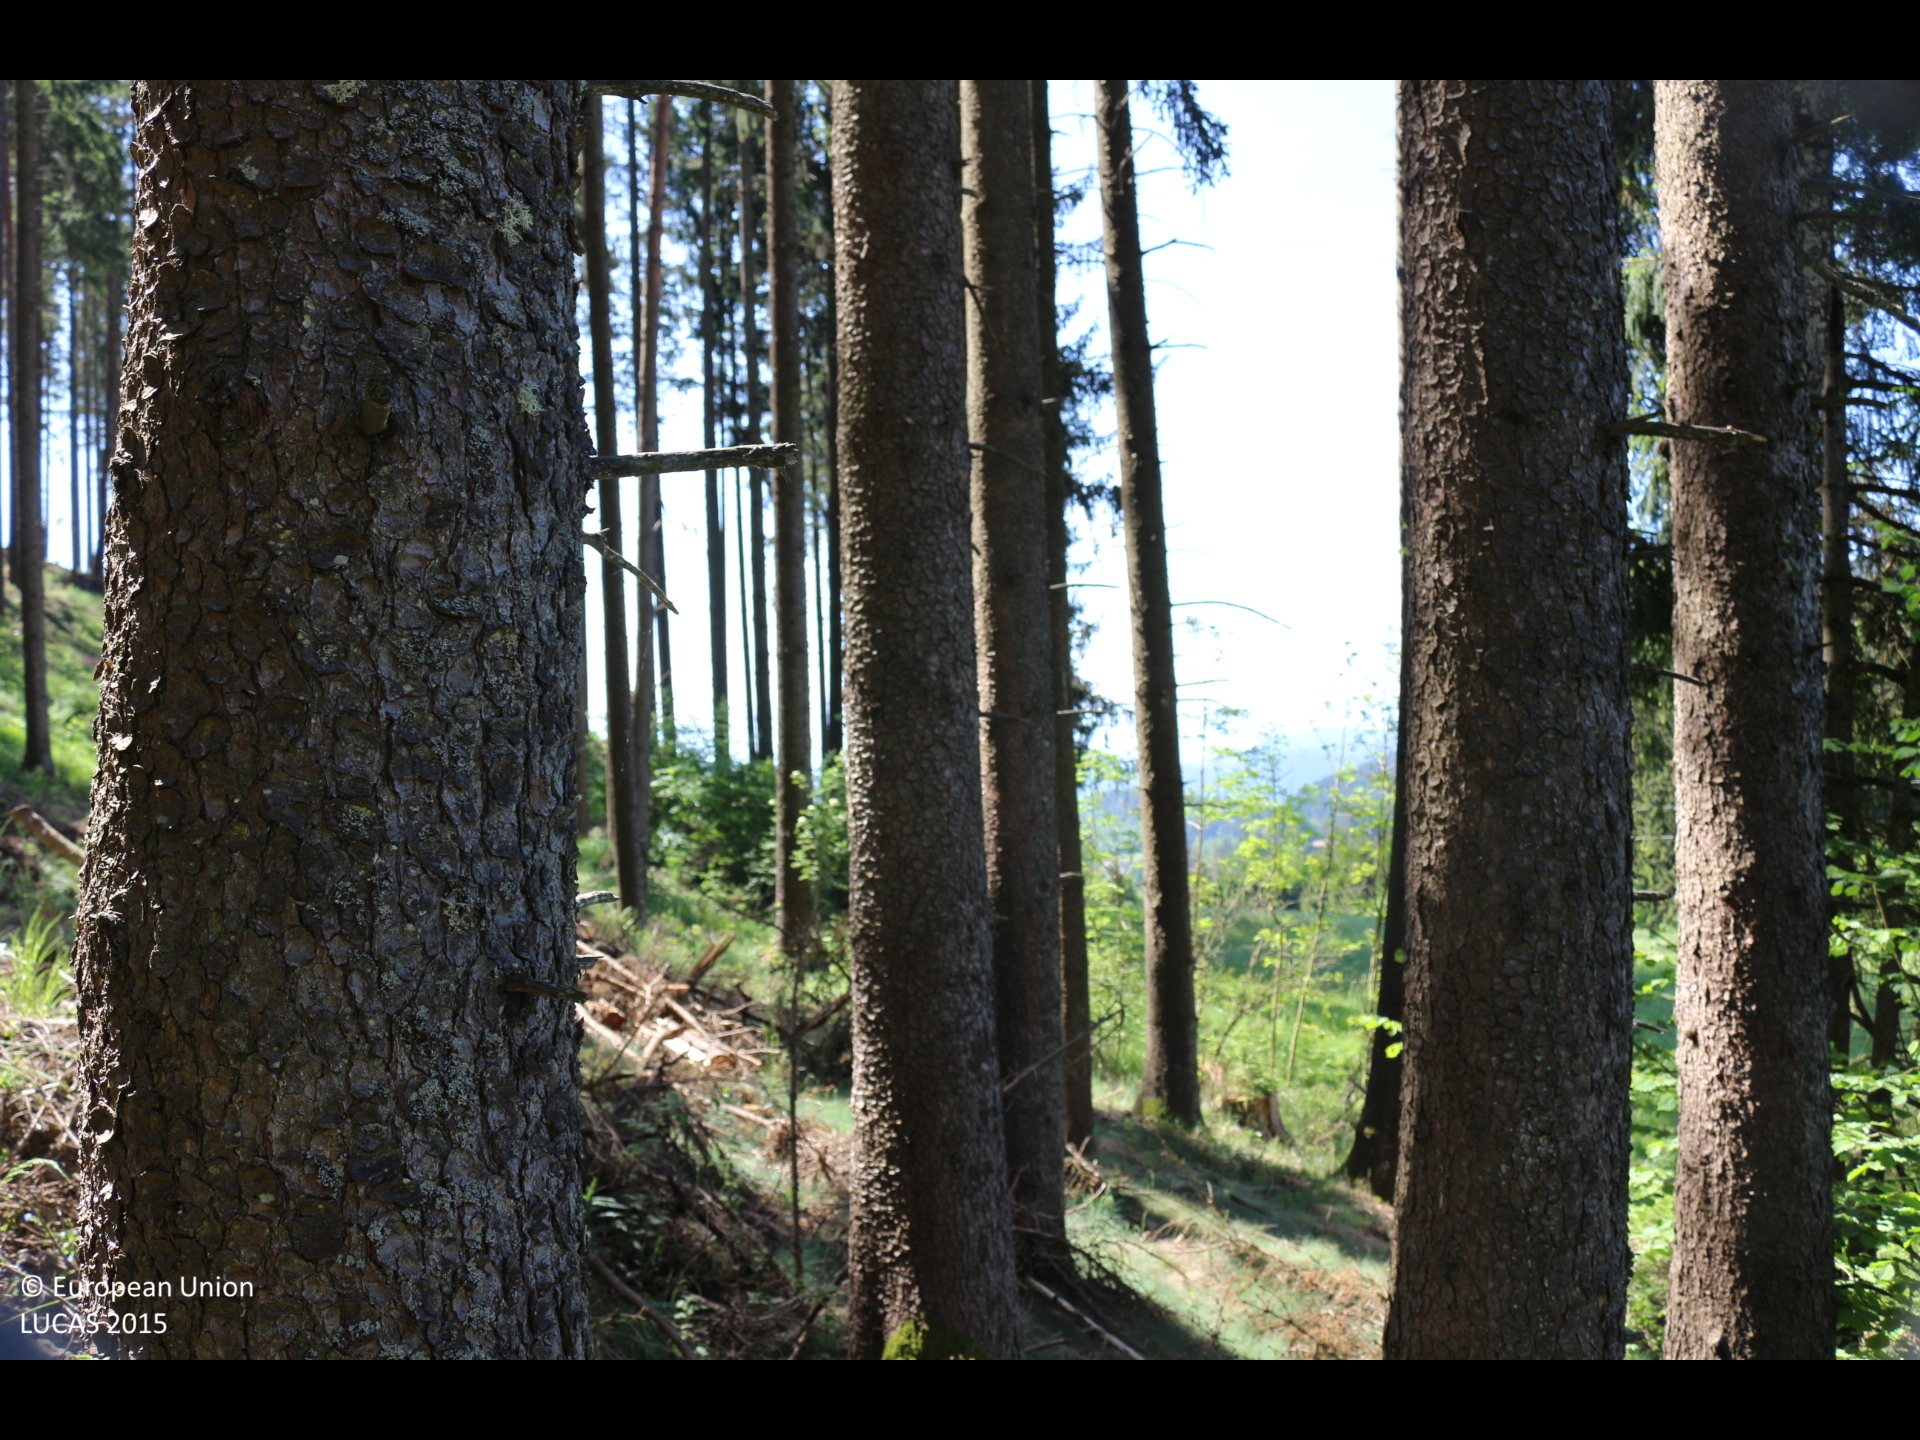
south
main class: Woodland
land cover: Spruce dominated coniferous woodland
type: alpine coniferous forest
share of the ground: > 75 %
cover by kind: coniferous forest trees 70 %, broadleaved forest trees 20 %, shrubs 10 %
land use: Forestry
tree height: > 5 m
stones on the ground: < 10 %
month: May
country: AT
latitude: 46.7864
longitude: 14.3336
